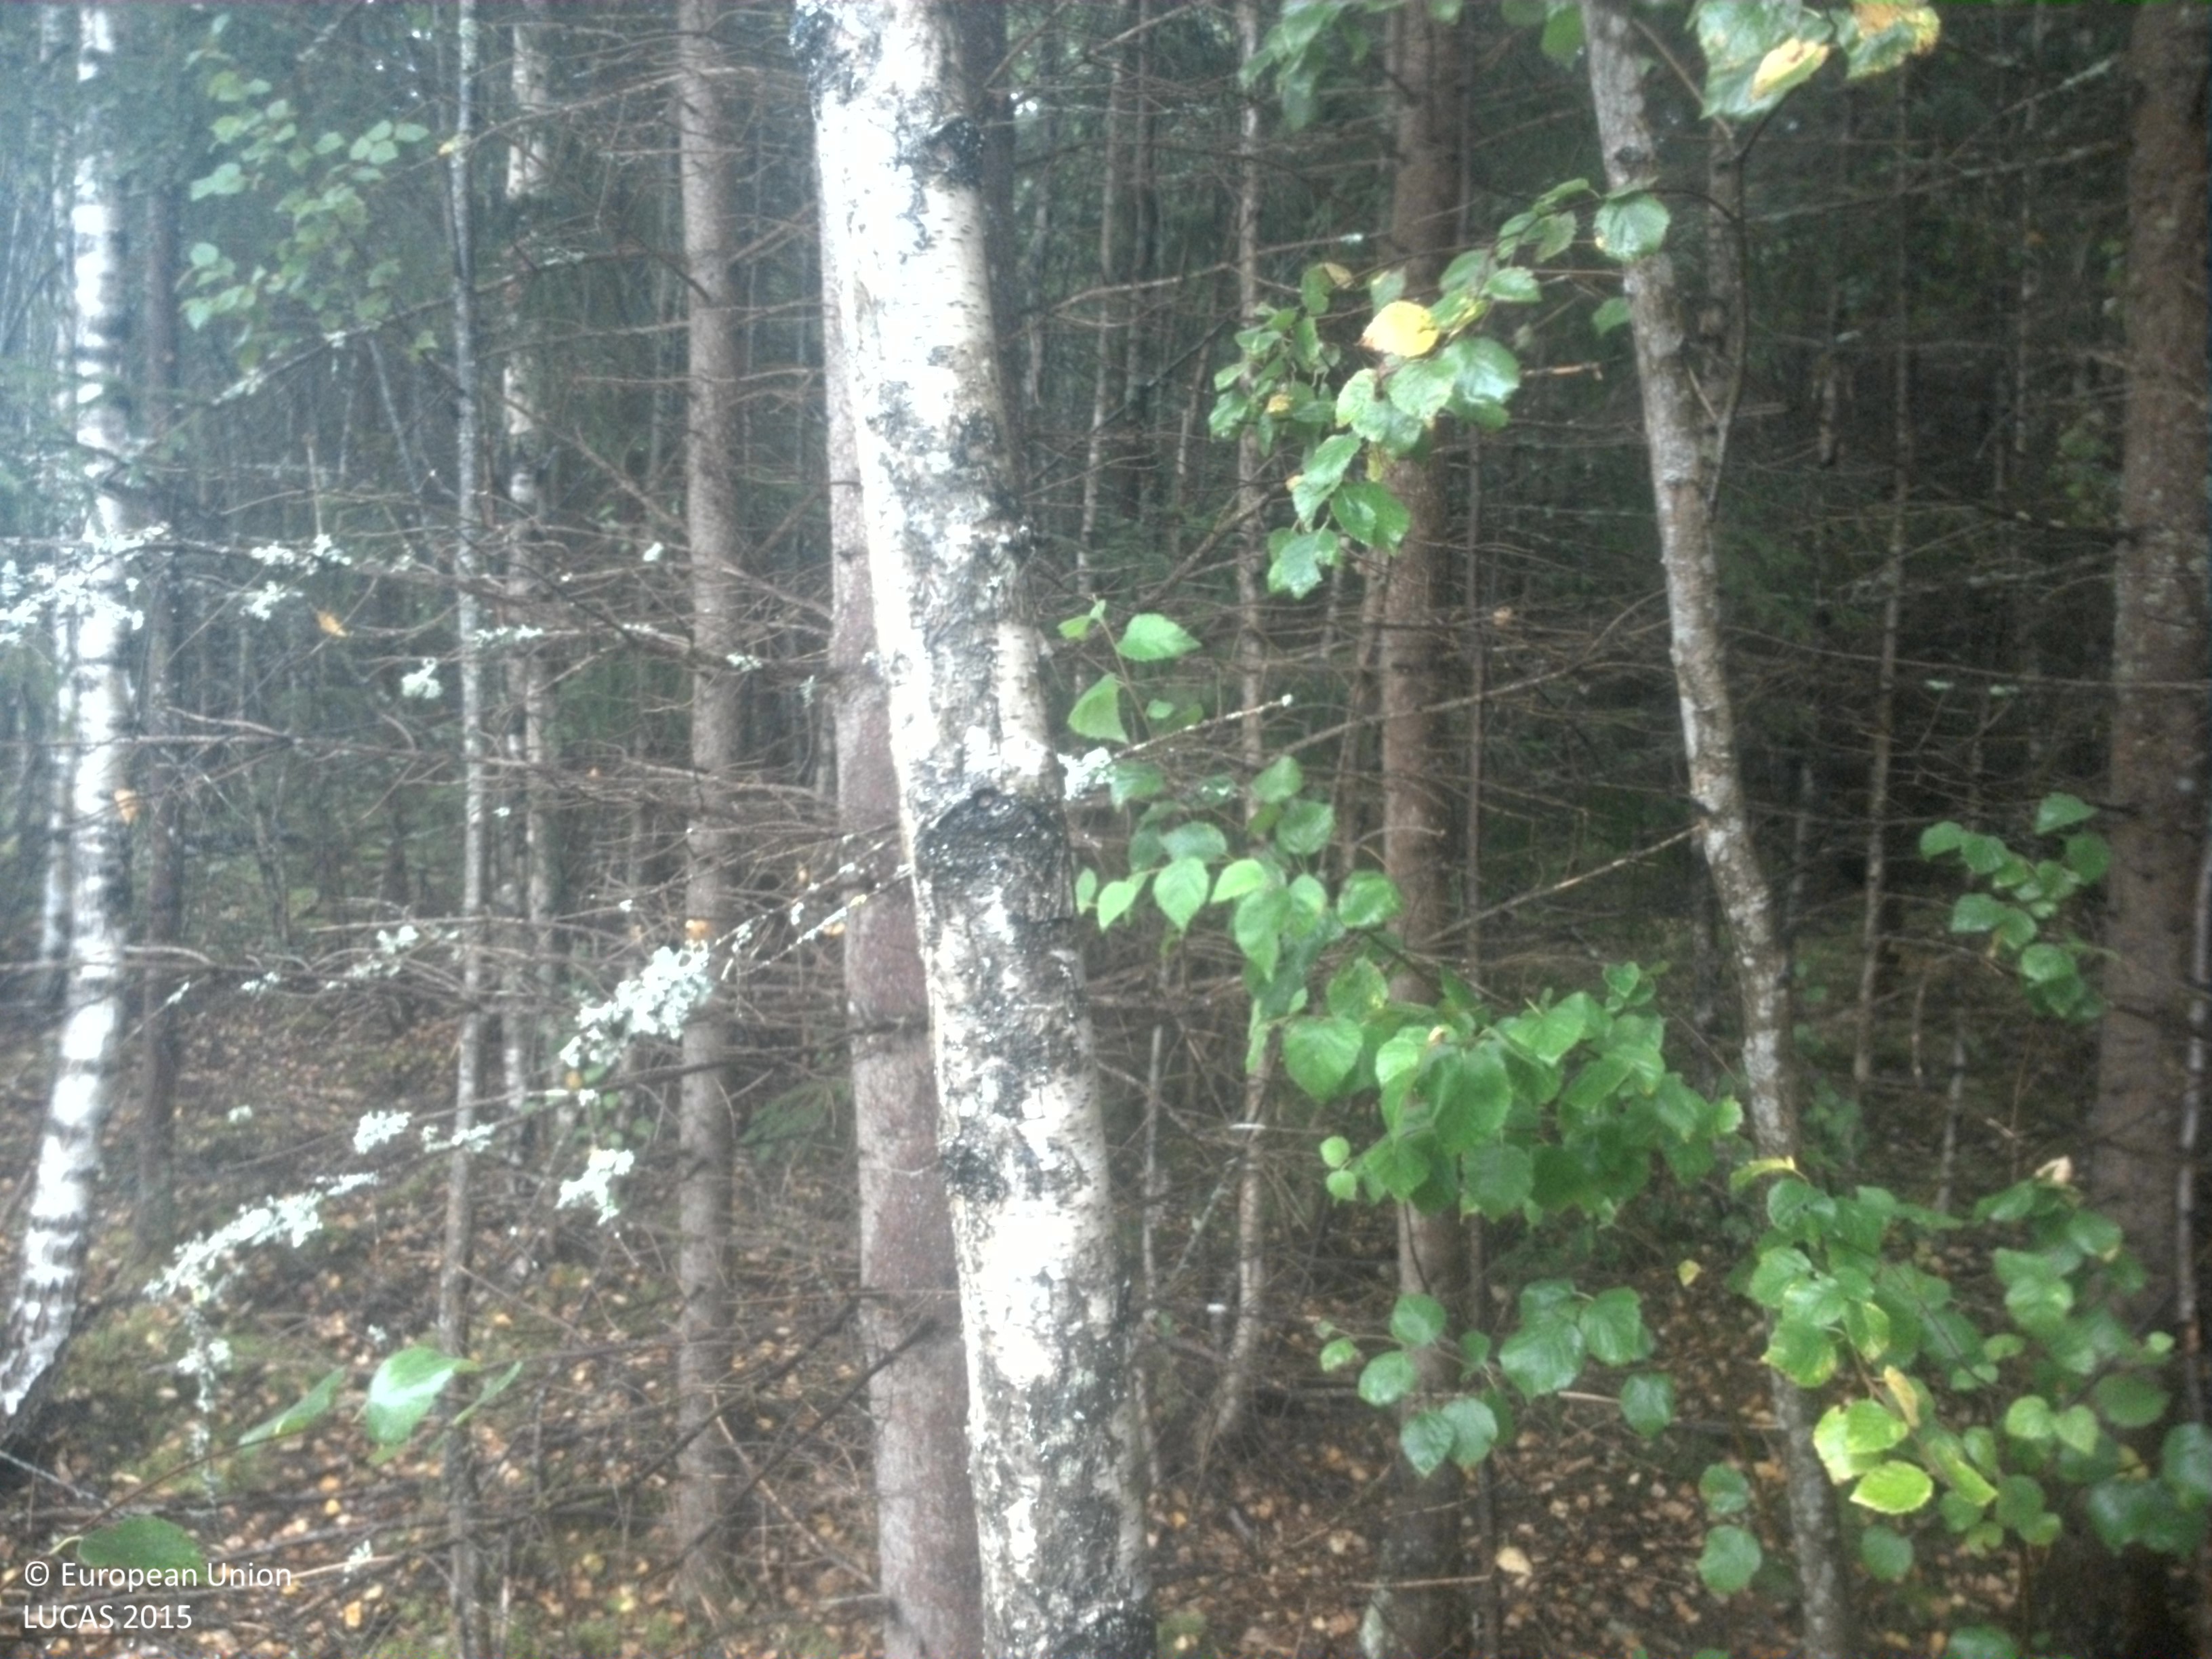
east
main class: Woodland
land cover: Spruce dominated mixed woodland
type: boreal forest
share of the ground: > 75 %
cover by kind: coniferous forest trees 55 %, broadleaved forest trees 30 %, lichens and mosses 5 %
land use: Forestry
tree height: > 5 m
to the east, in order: Spruce dominated mixed woodland; Electric lines; Spruce dominated mixed woodland; Groves; Grassland without tree/shrub cover
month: August
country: SE
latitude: 59.6286
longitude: 15.7892
